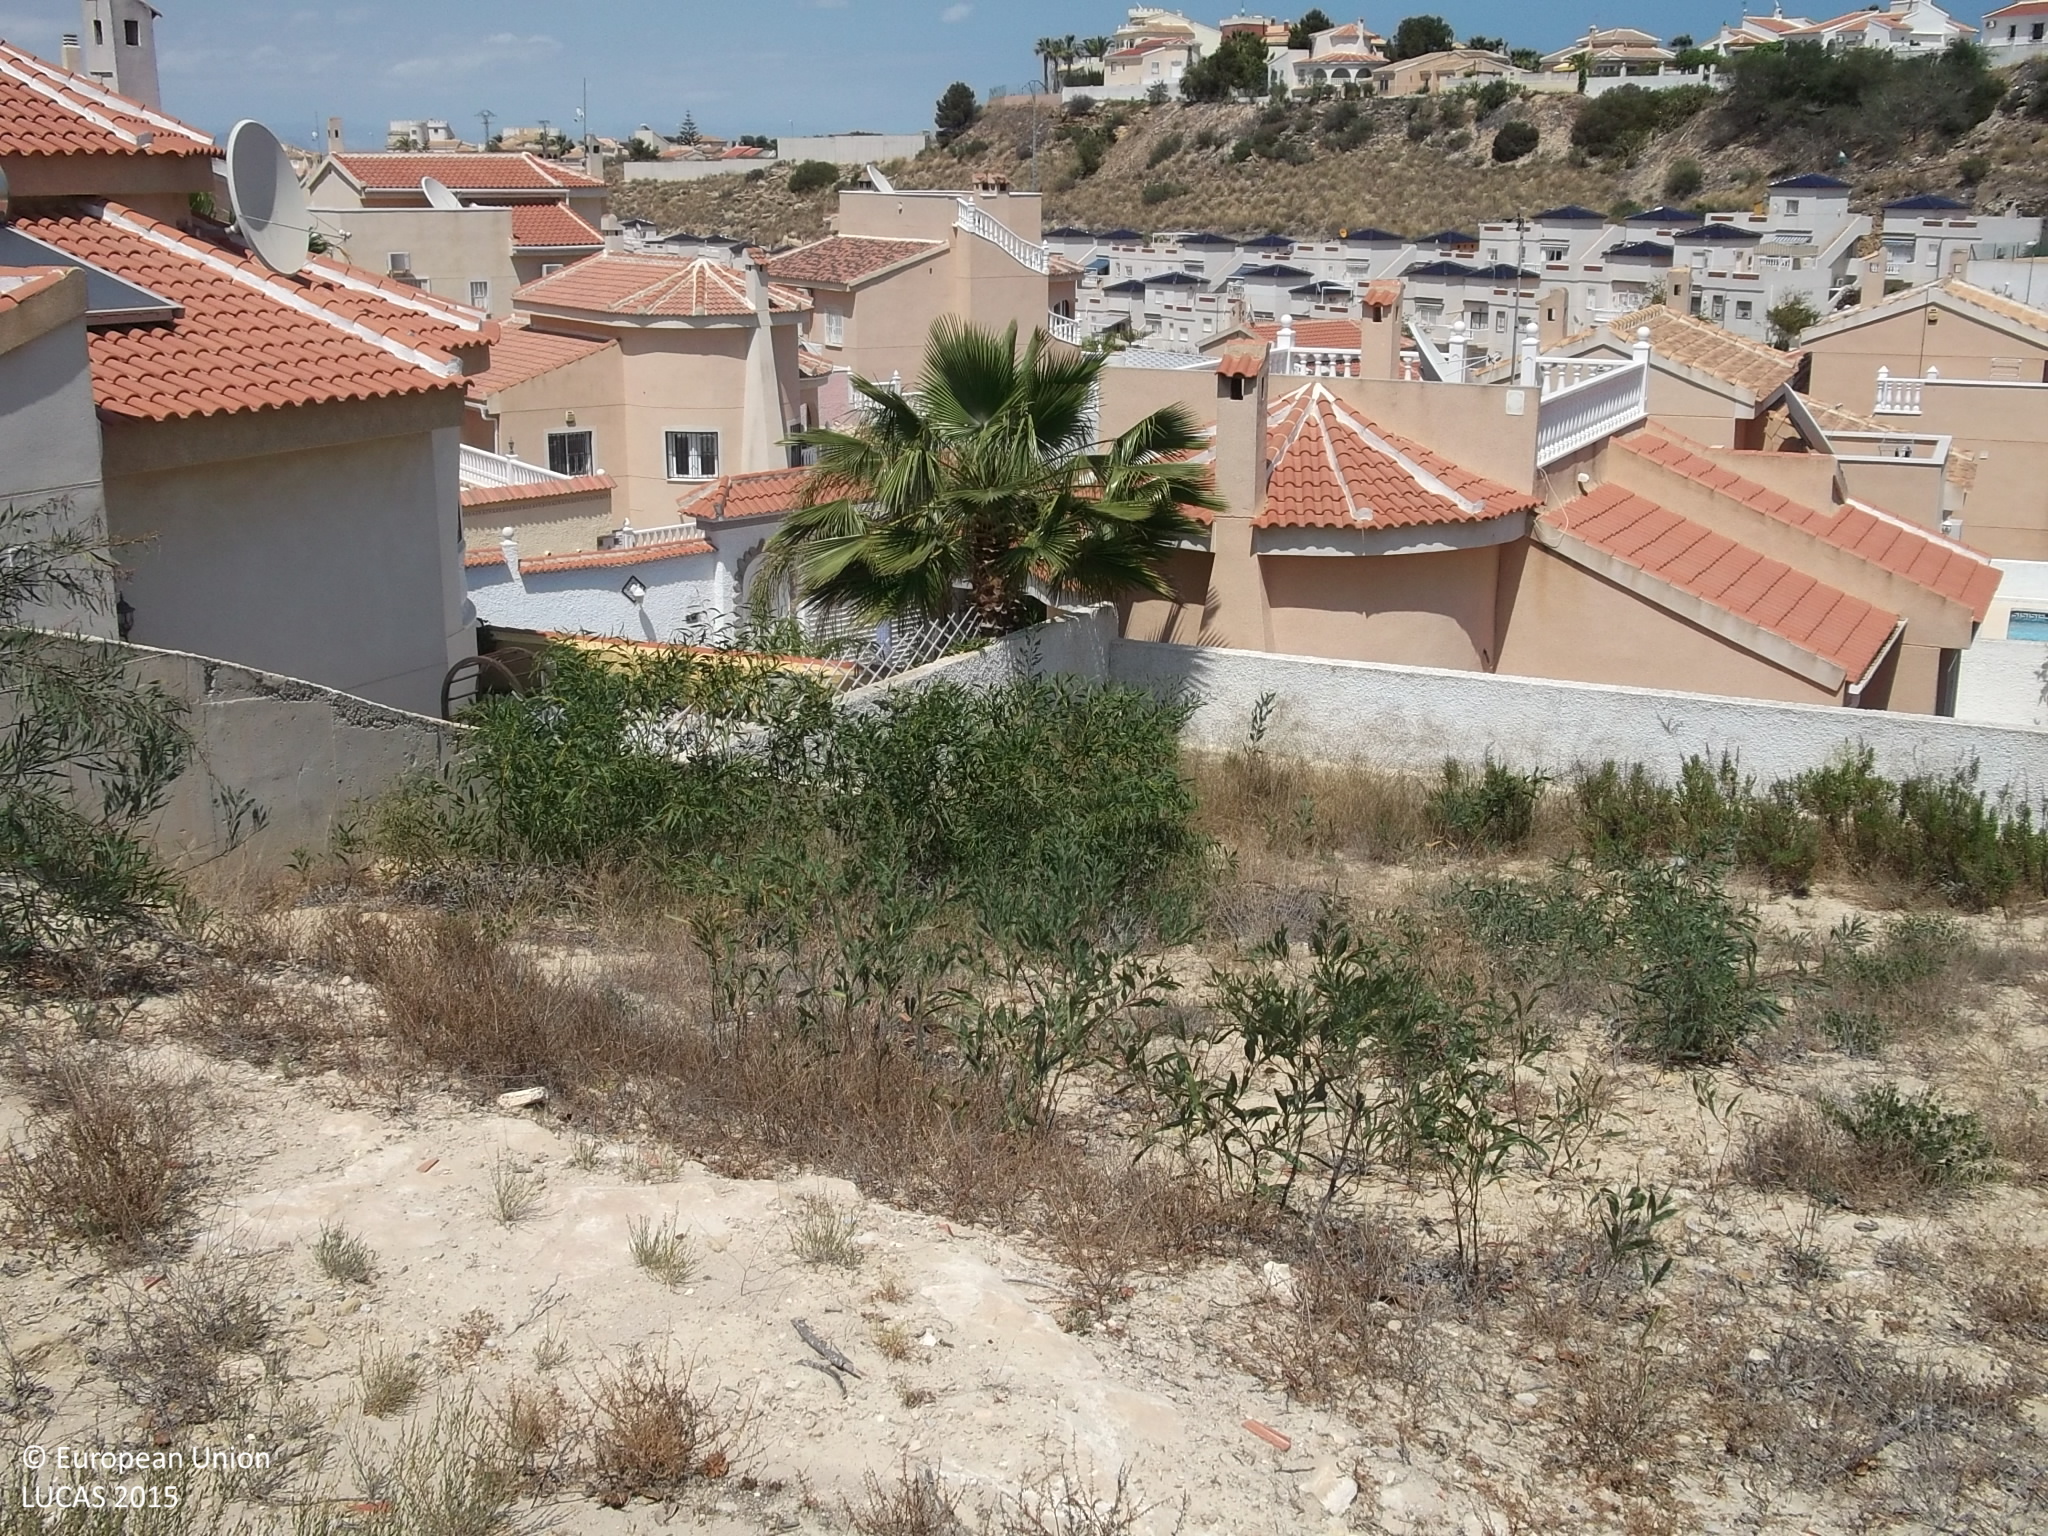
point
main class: Shrubland
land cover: Shrubland with sparse tree cover
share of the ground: 10 - 25 %
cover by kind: consolidated bare surface 50 %, herbaceous plants 30 %, shrubs 15 %, broadleaved forest trees 5 %
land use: Residential
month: May
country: ES
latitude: 38.0730
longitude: -0.7099
